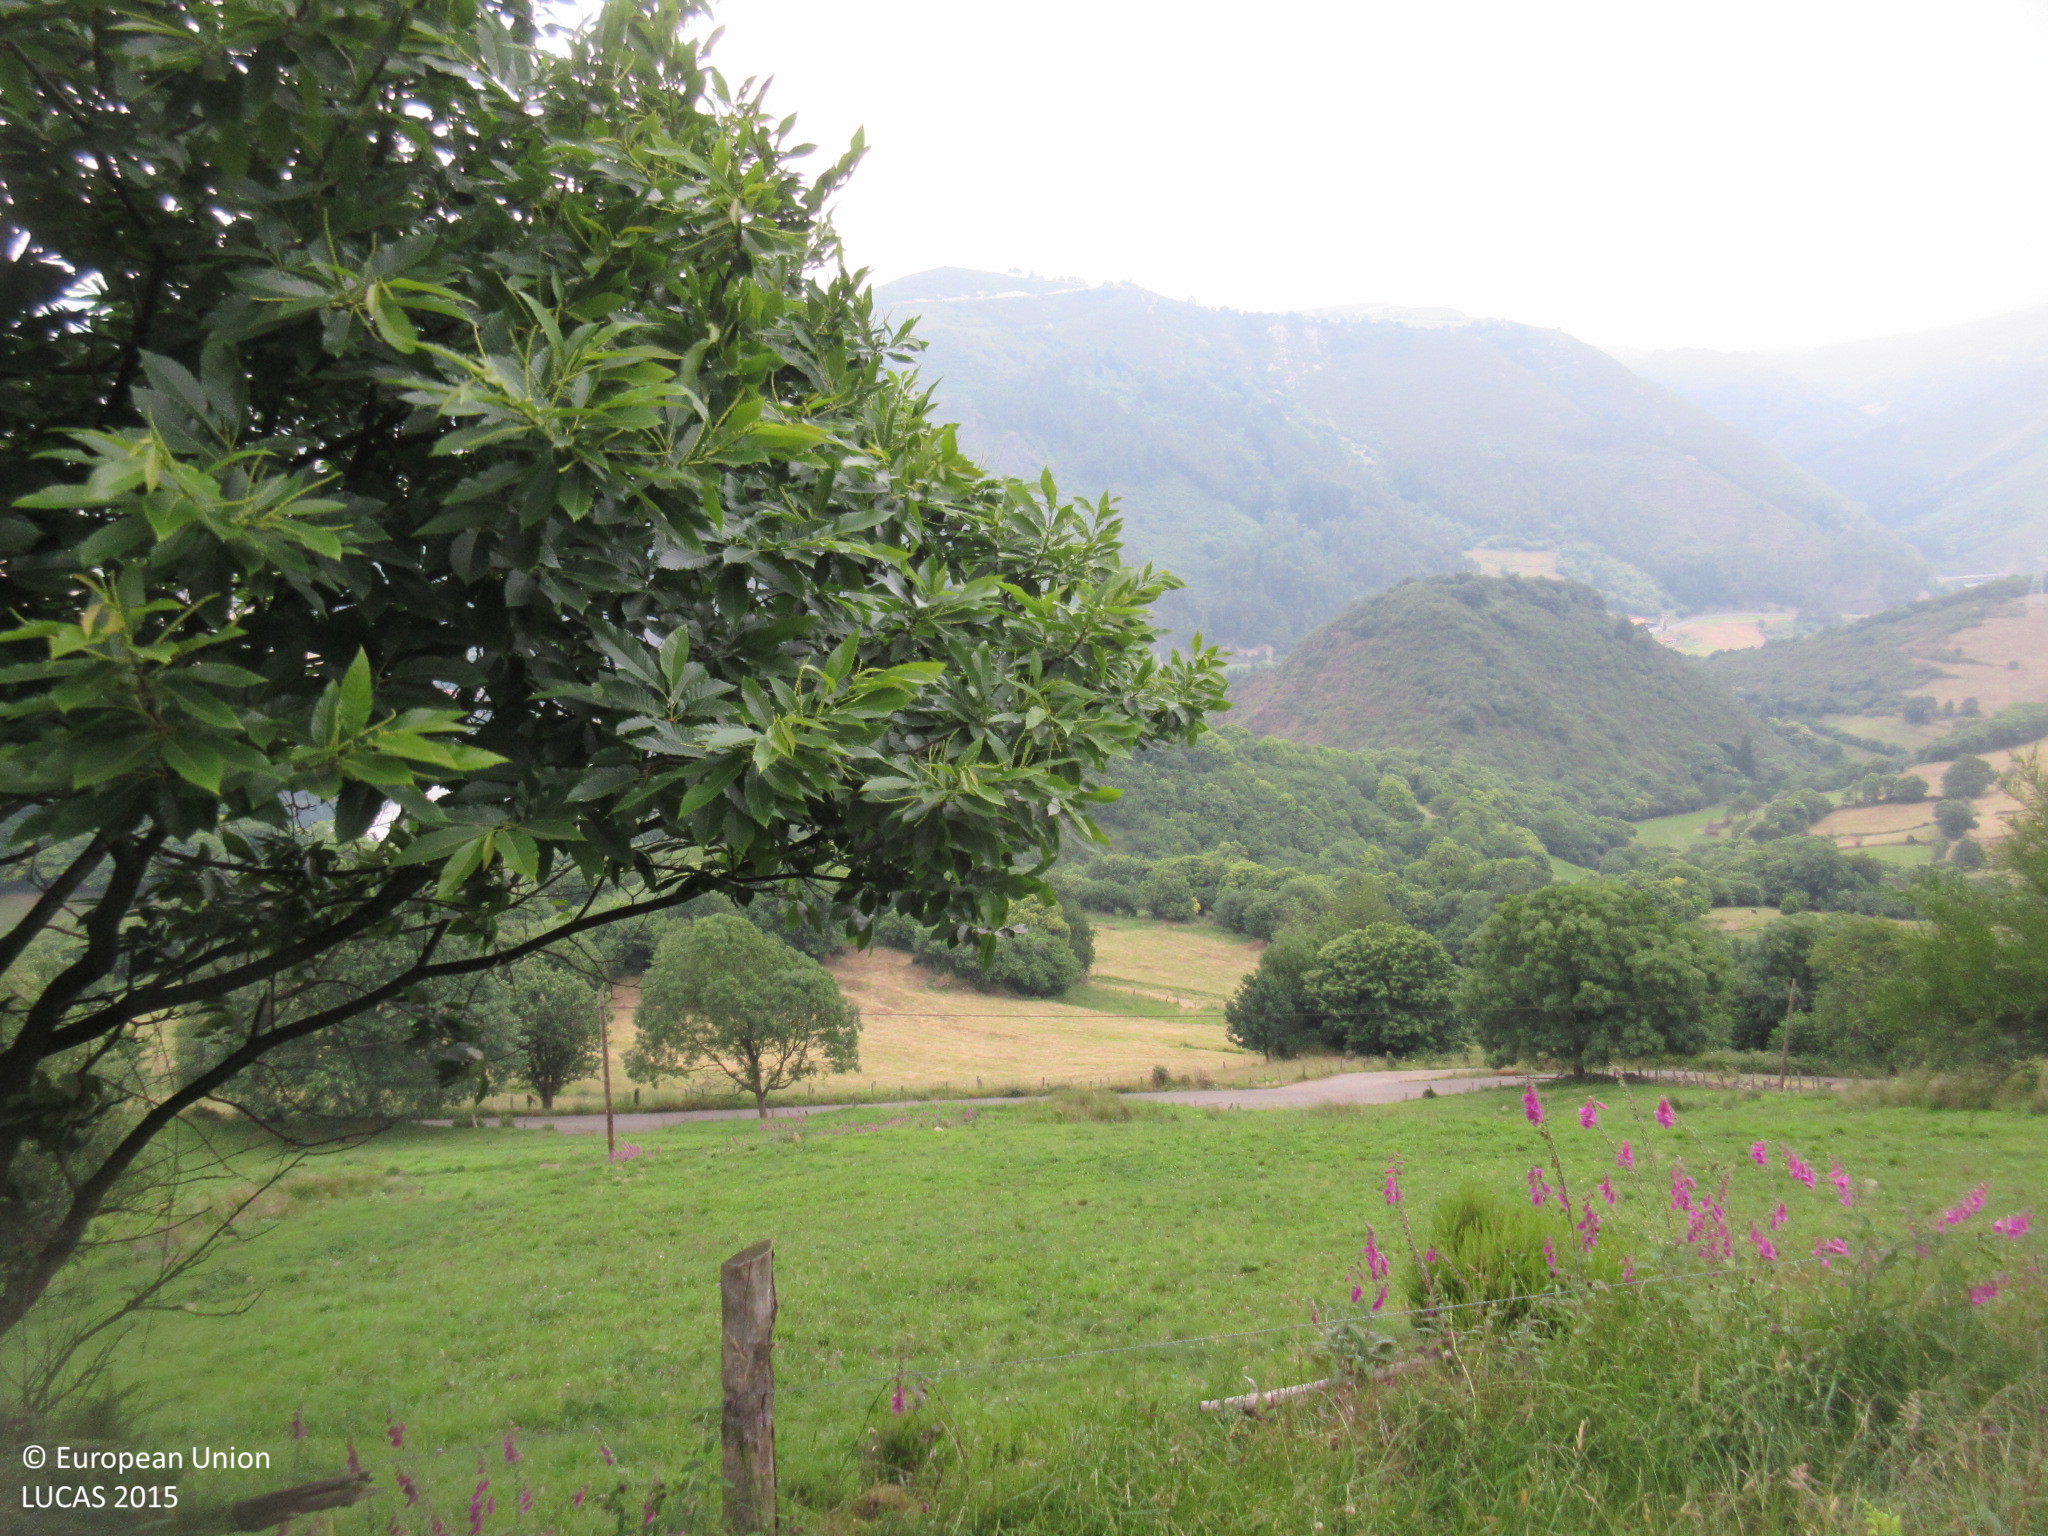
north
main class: Grassland
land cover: Grassland without tree/shrub cover
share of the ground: > 75 %
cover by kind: herbaceous plants 100 %
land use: Agriculture (excluding fallow land and kitchen gardens)
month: June
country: ES
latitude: 43.2815
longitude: -6.3527
